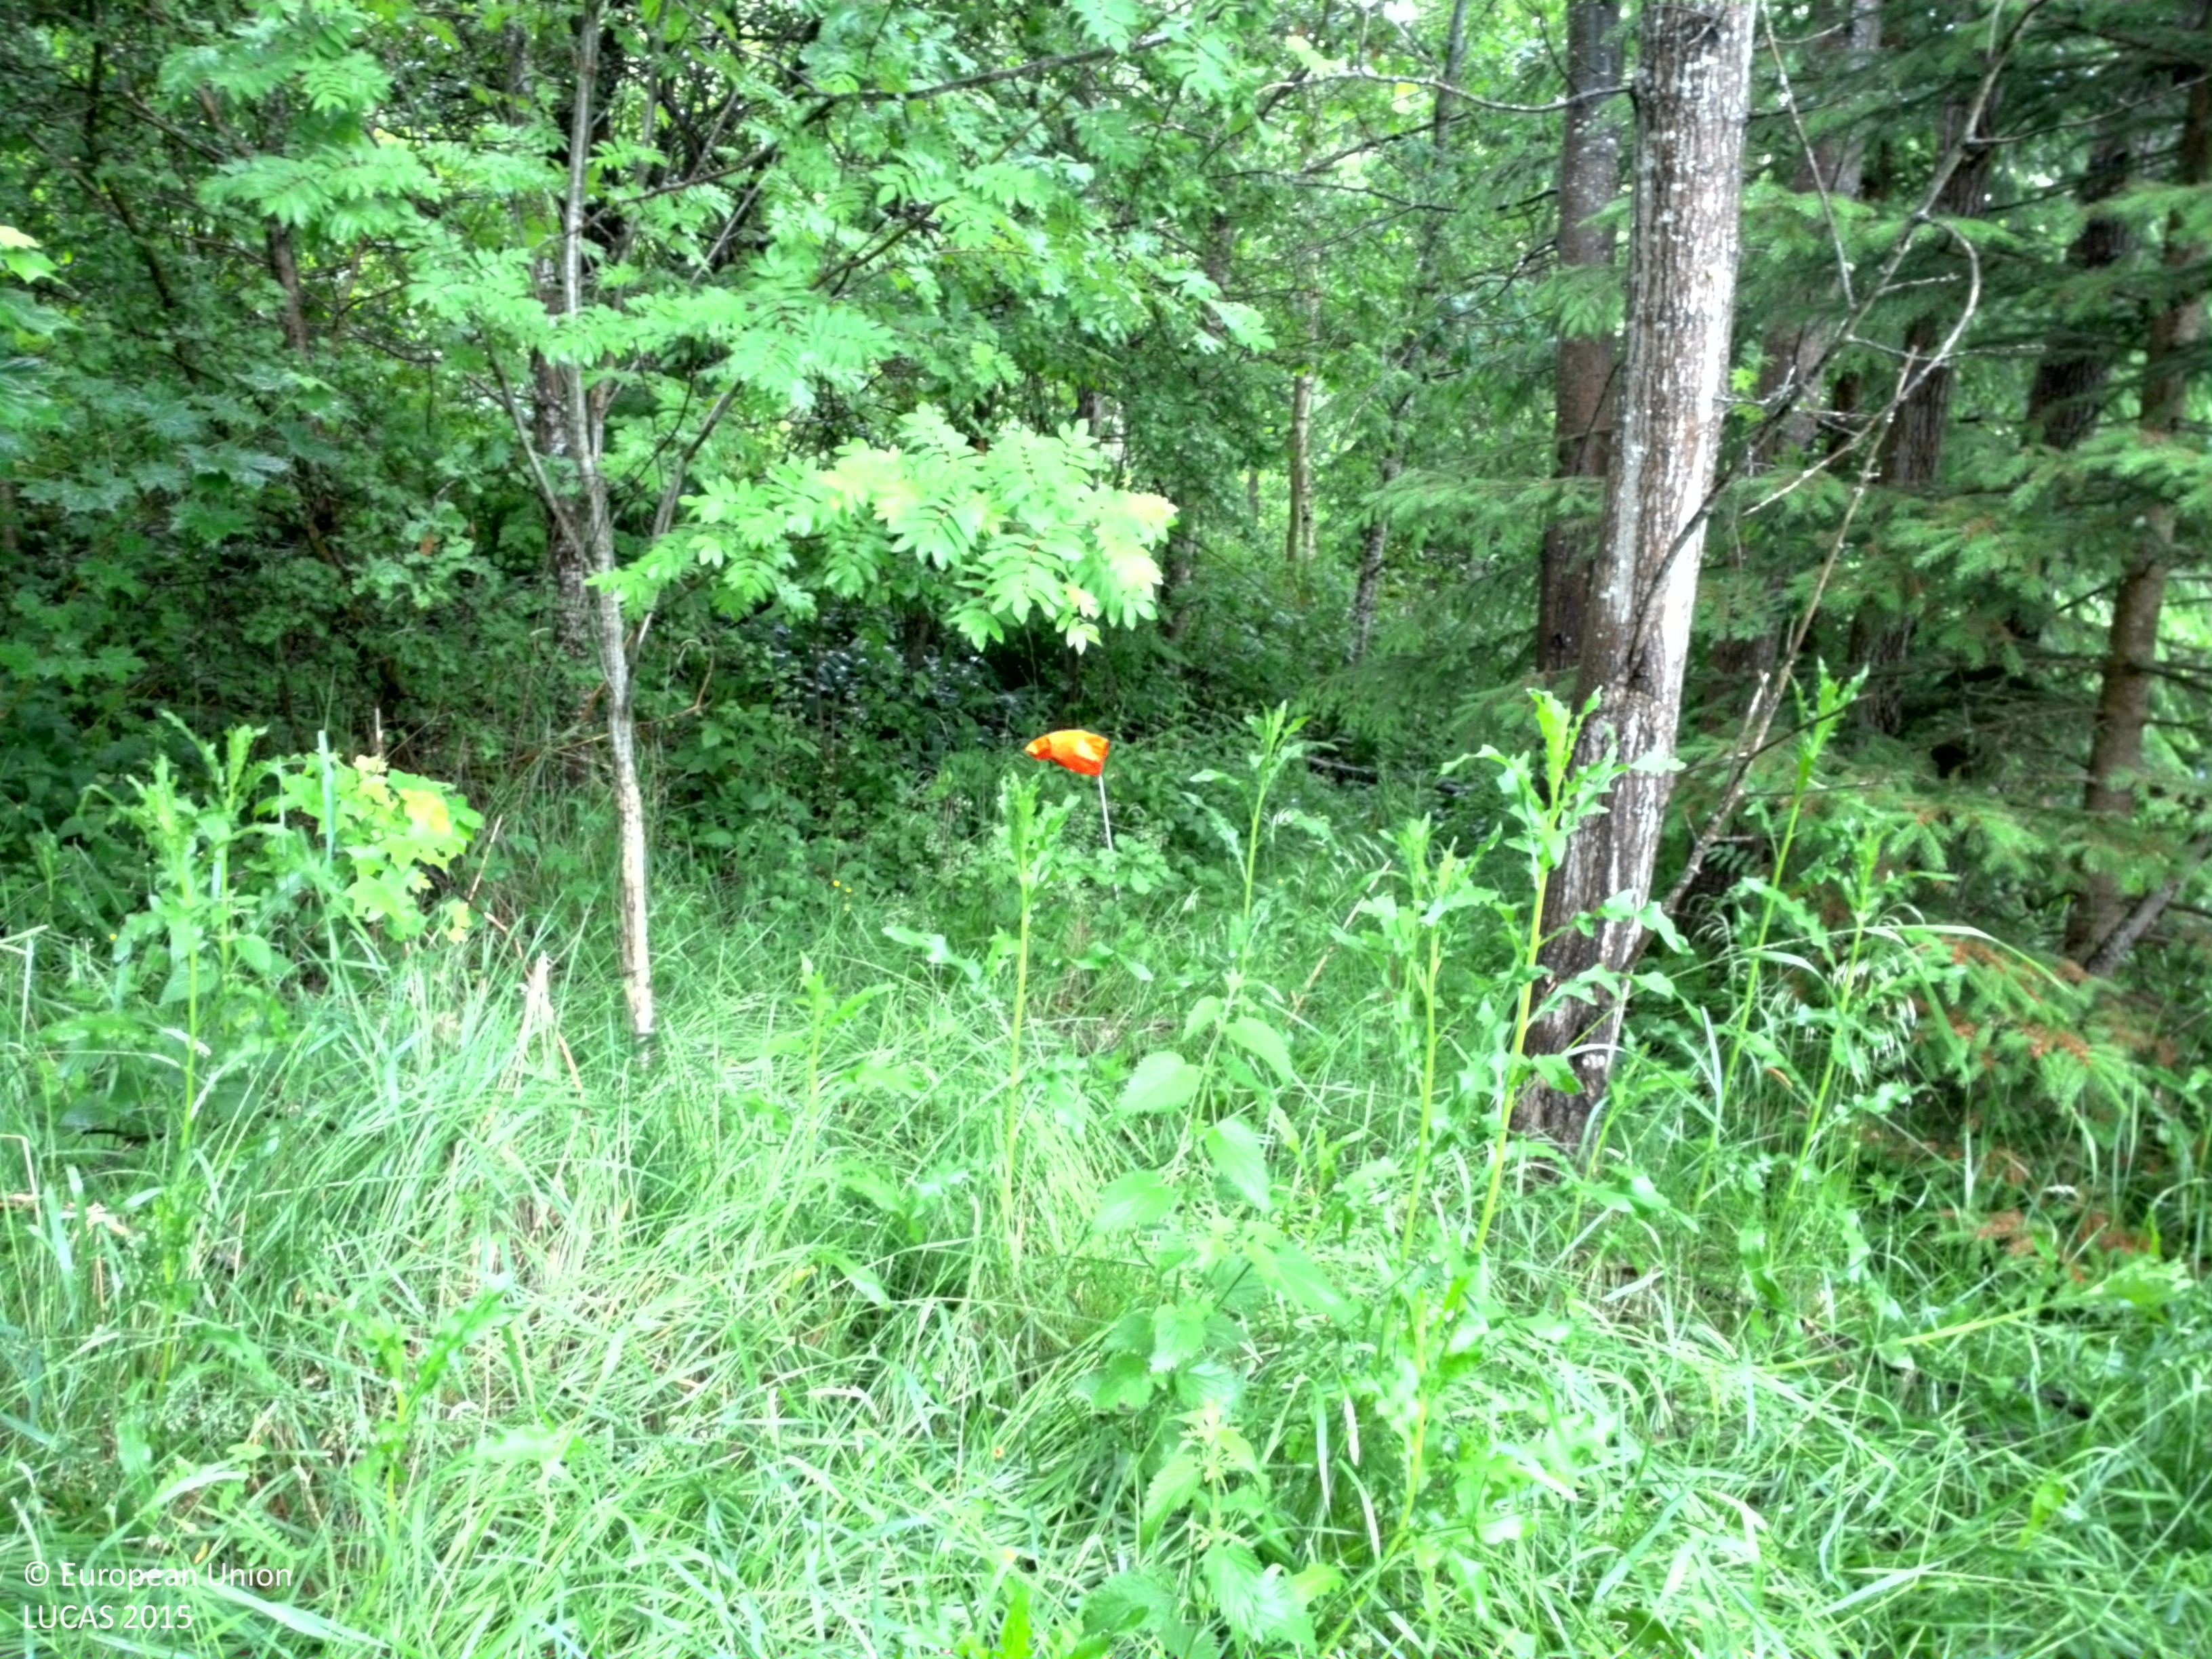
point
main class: Woodland
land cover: Broadleaved woodland
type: acidophilous oak and oak-birch forest
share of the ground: > 75 %
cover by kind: broadleaved forest trees 85 %, herbaceous plants 15 %
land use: Forestry
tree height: > 5 m
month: June
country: SE
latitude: 58.7243
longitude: 15.3987
